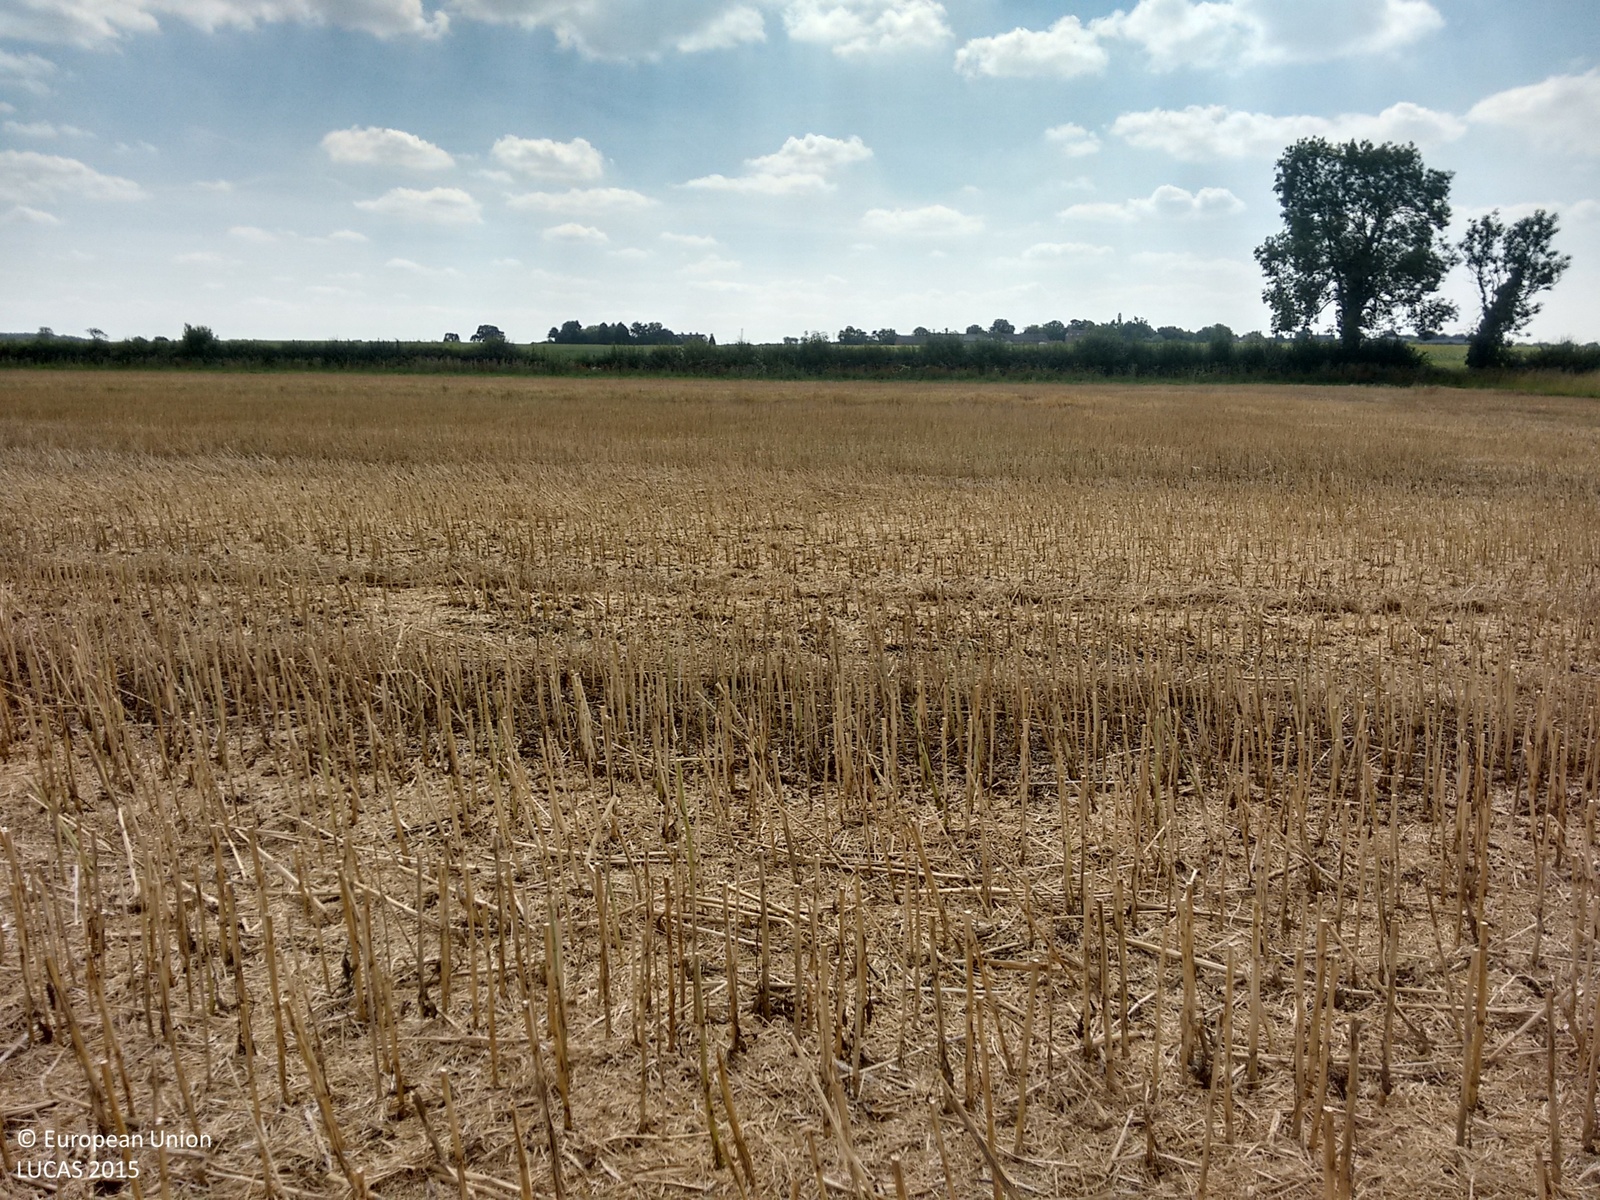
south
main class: Cropland
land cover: Rape and turnip rape
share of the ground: > 75 %
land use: Agriculture (excluding fallow land and kitchen gardens)
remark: Harvested field
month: August
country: GB
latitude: 52.6011
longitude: -1.4635
